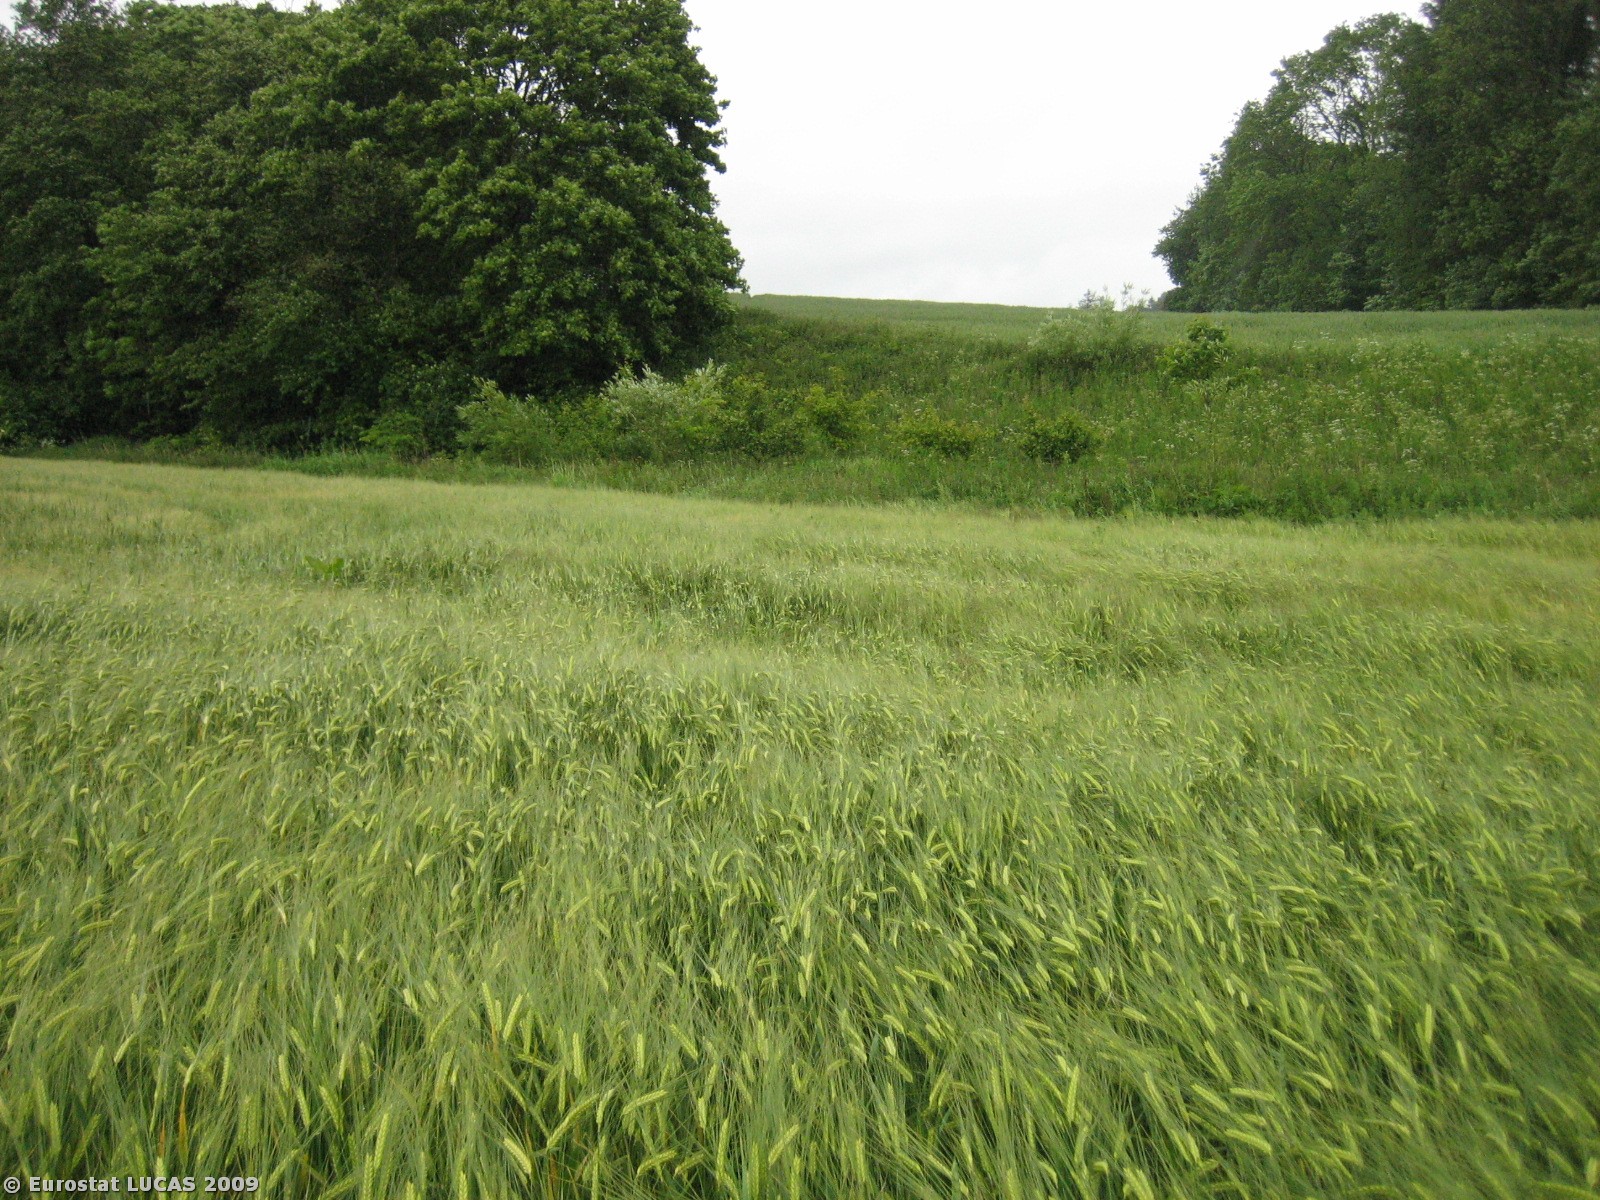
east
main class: Cropland
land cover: Barley
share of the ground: > 75 %
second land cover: Common wheat
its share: < 10 %
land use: Agriculture (excluding fallow land and kitchen gardens)
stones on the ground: < 10 %
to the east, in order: Barley; Common wheat; Grass margins; Broadleaved woodland; Common wheat
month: June
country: DK
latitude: 55.9900
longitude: 10.0160
